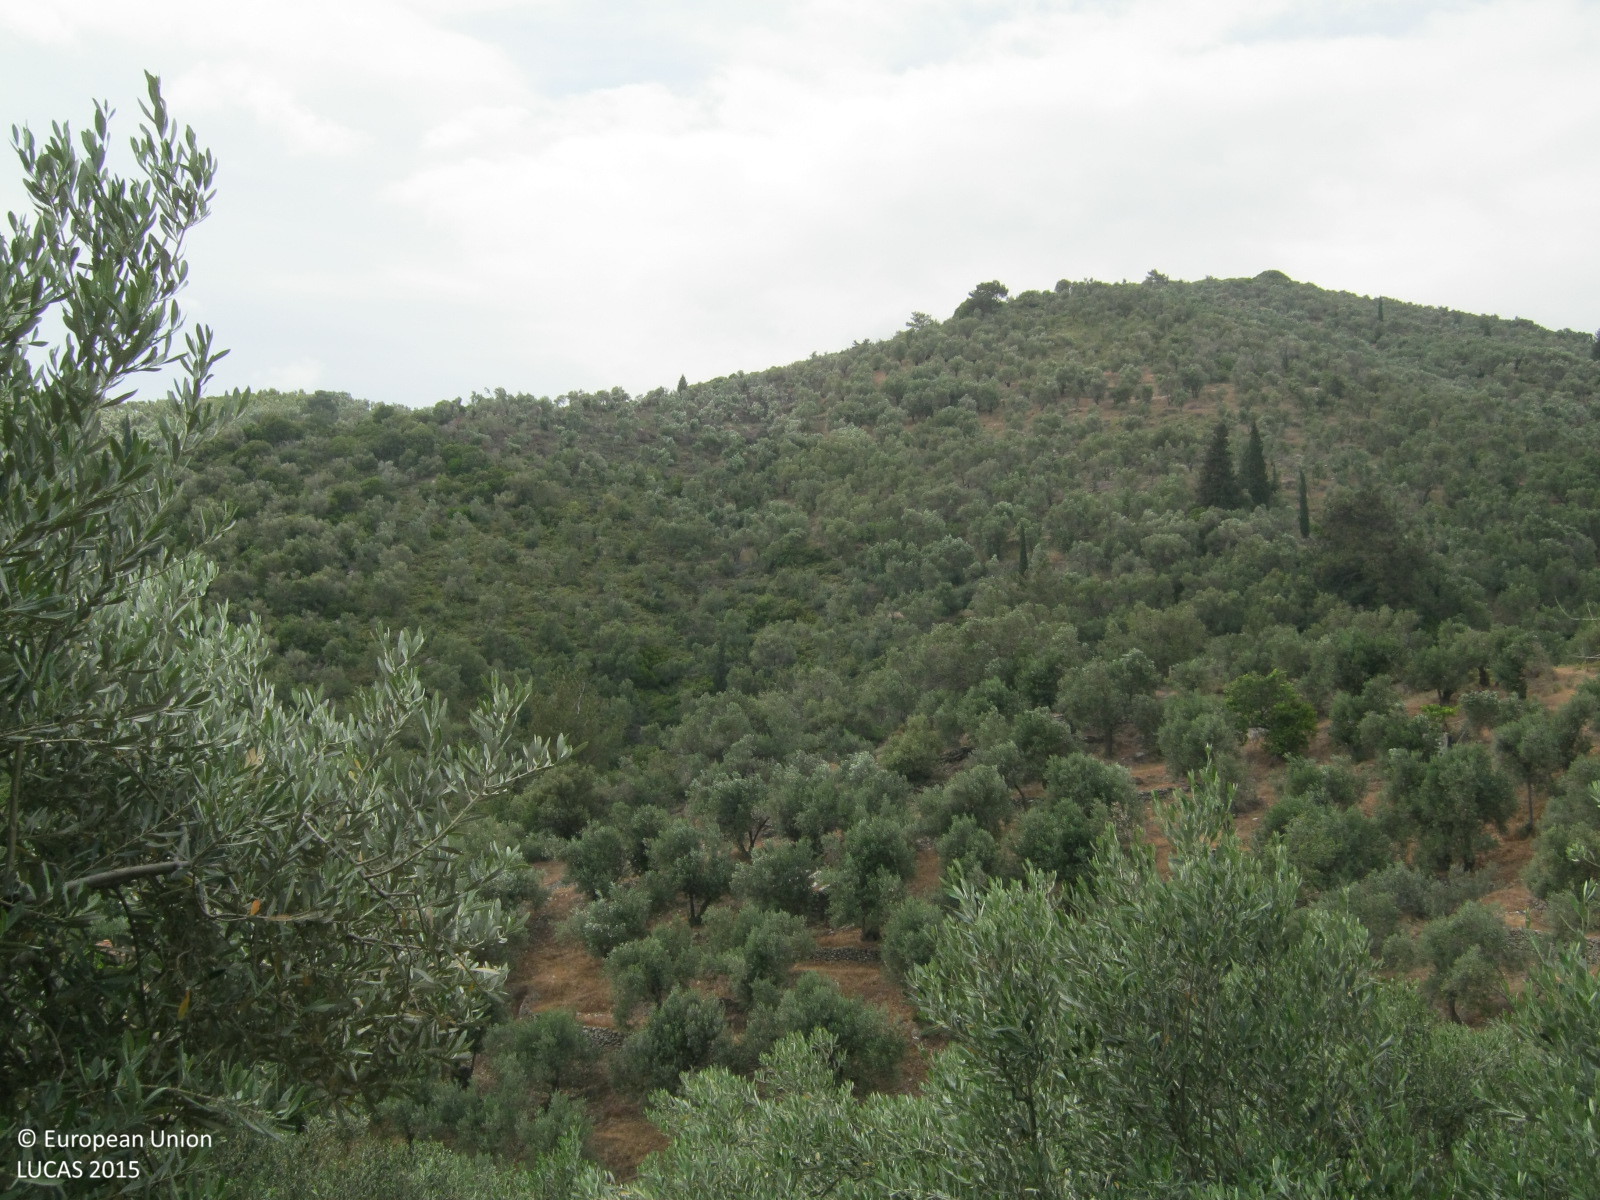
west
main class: Cropland
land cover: Olive groves
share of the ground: 50 - 75 %
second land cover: Grassland without tree/shrub cover
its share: > 75 %
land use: Agriculture (excluding fallow land and kitchen gardens)
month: May
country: GR
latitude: 38.9900
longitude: 26.4905
